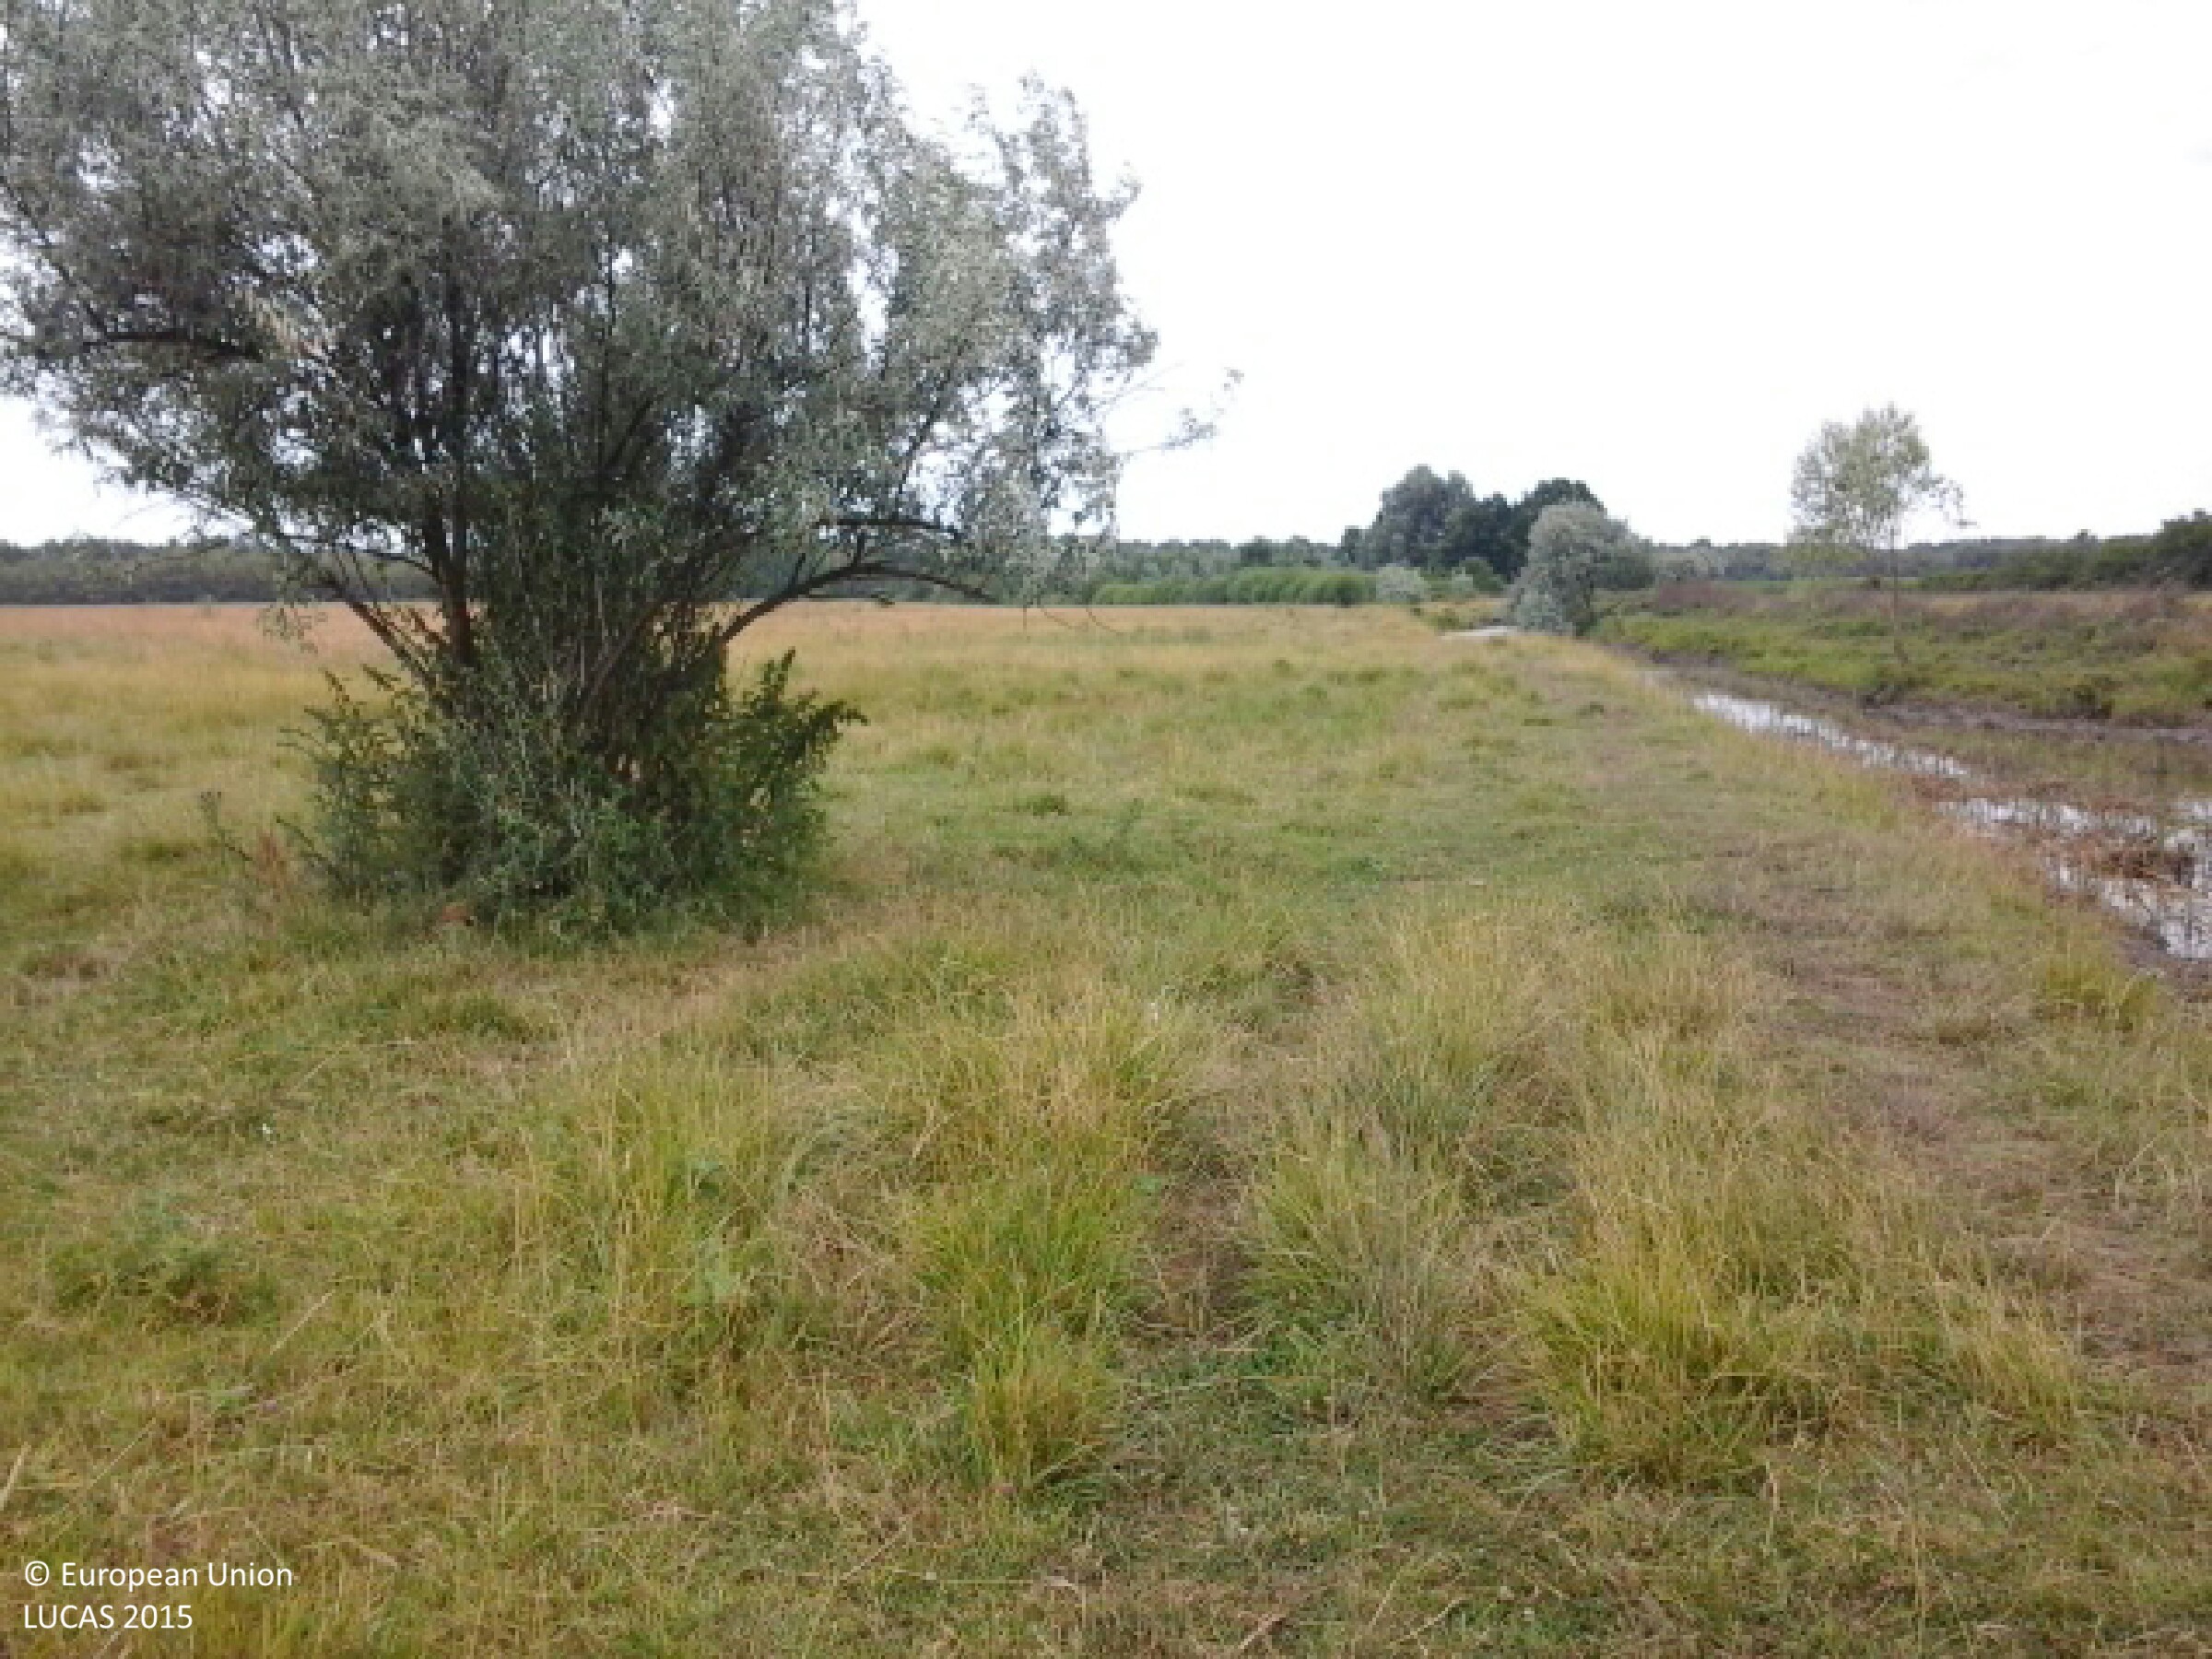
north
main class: Grassland
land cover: Grassland without tree/shrub cover
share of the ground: > 75 %
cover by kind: herbaceous plants 100 %
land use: Agriculture (excluding fallow land and kitchen gardens)
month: June
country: HU
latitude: 48.0595
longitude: 21.4636
